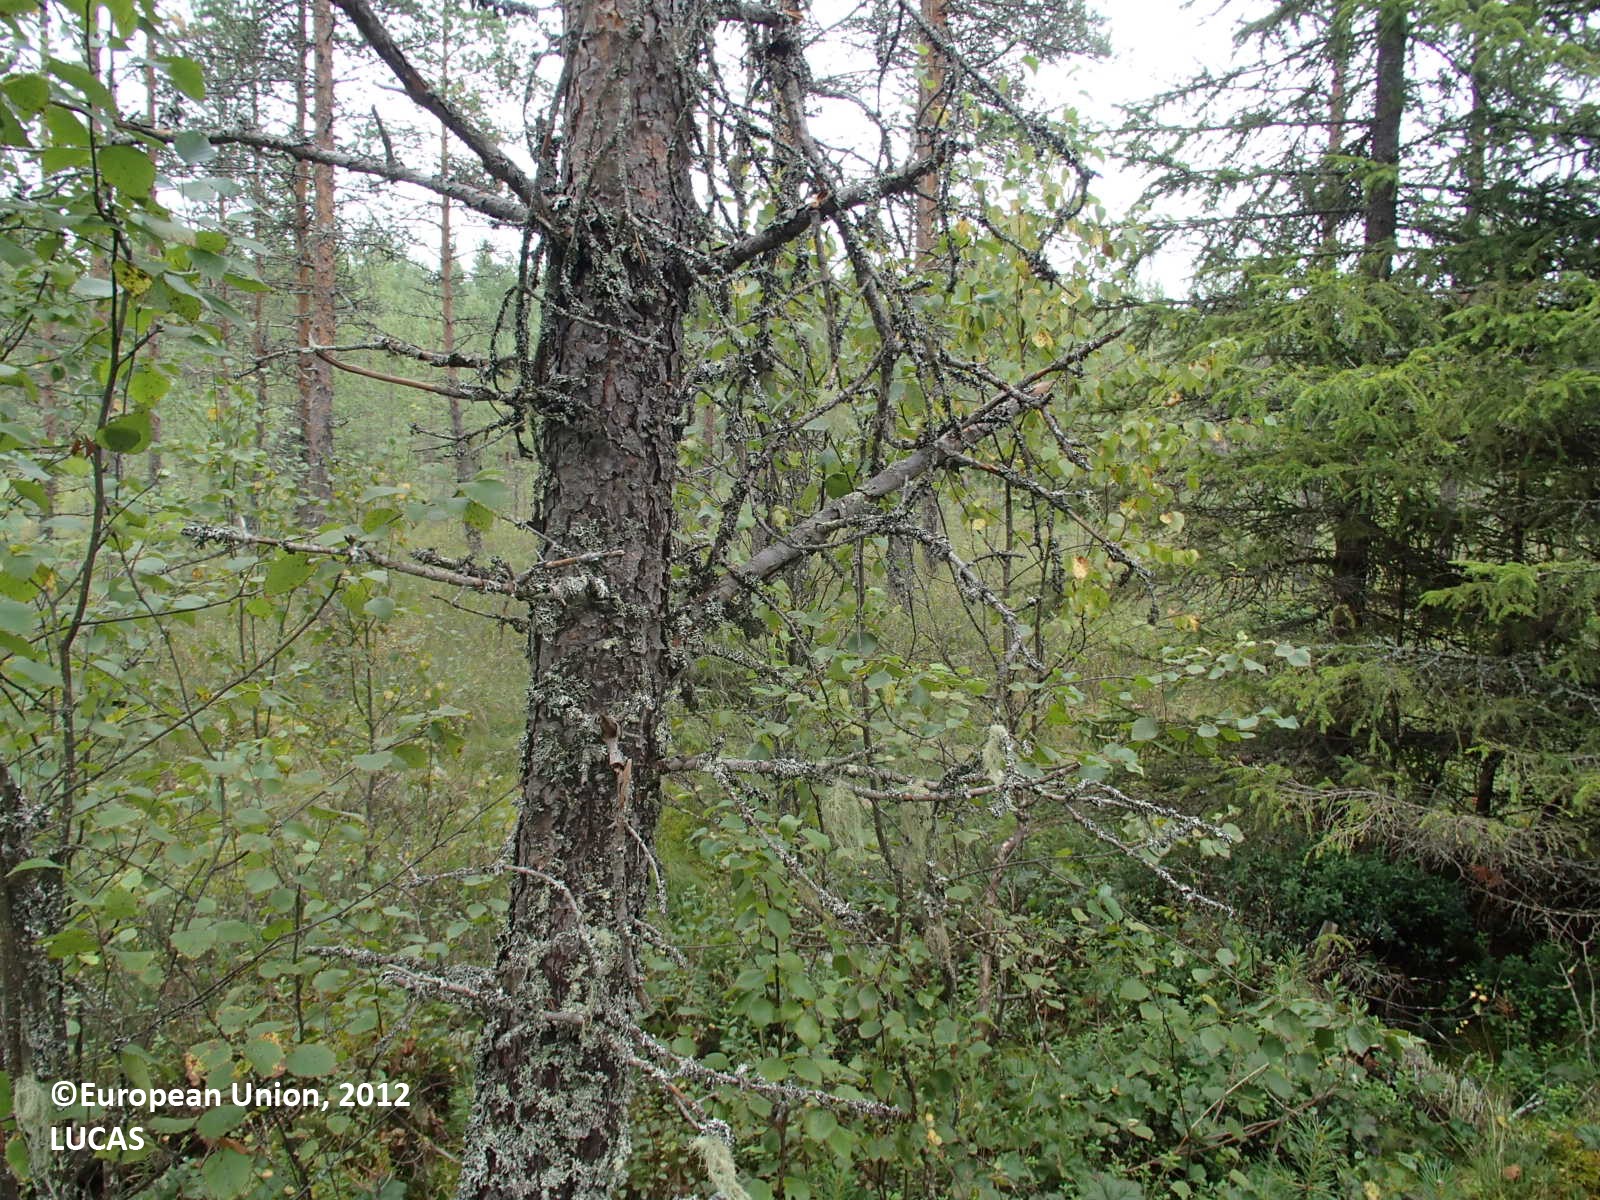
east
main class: Woodland
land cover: Other coniferous woodland
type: boreal forest
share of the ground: > 75 %
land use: Forestry
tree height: > 5 m
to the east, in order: Other coniferous woodland; Pine dominated mixed woodland; Ditches and canals; Pine dominated coniferous woodland; Ditches and canals; Pine dominated coniferous woodland; Ditches and canals; Pine dominated mixed woodland; Spruce dominated mixed woodland
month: August
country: FI
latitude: 63.6314
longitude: 27.8642
